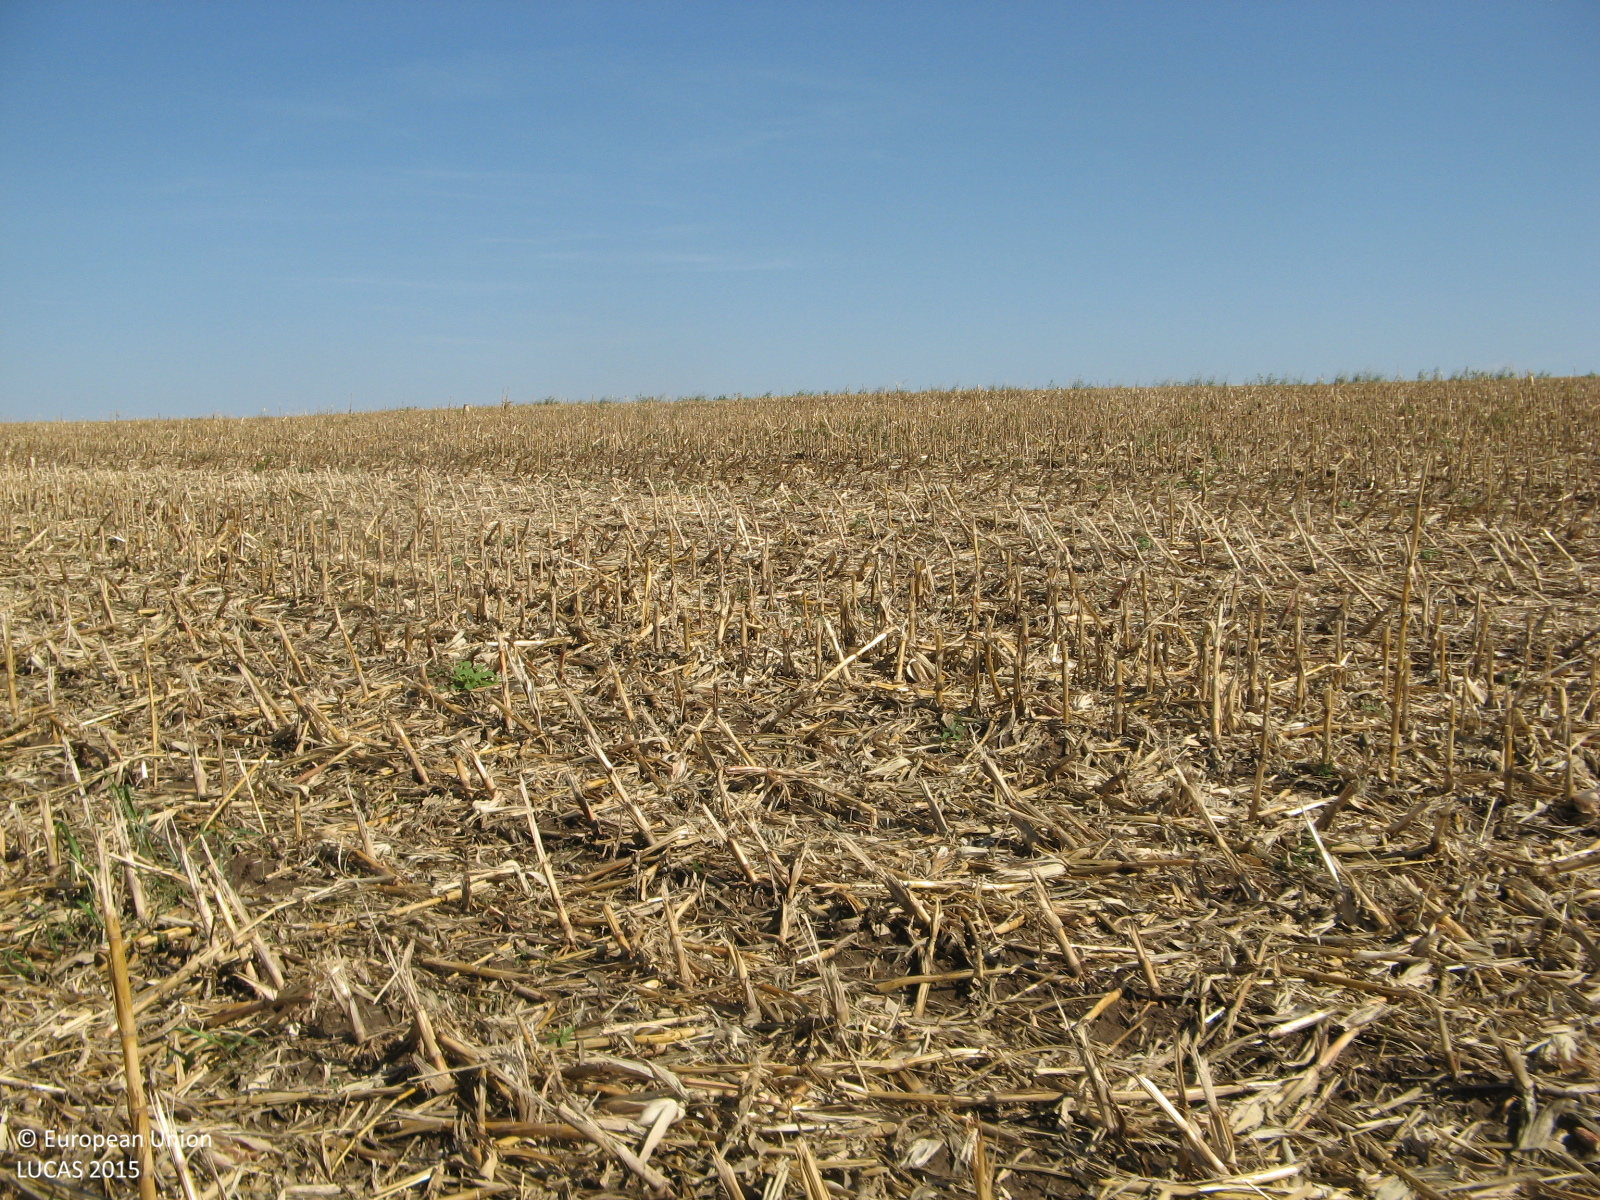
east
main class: Cropland
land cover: Maize
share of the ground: 10 - 25 %
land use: Agriculture (excluding fallow land and kitchen gardens)
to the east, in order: Maize; Grass margins; Tracks; Grass margins; Other bare soil; Common wheat; Grass margins; Maize
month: September
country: BG
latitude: 43.5686
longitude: 25.6997
